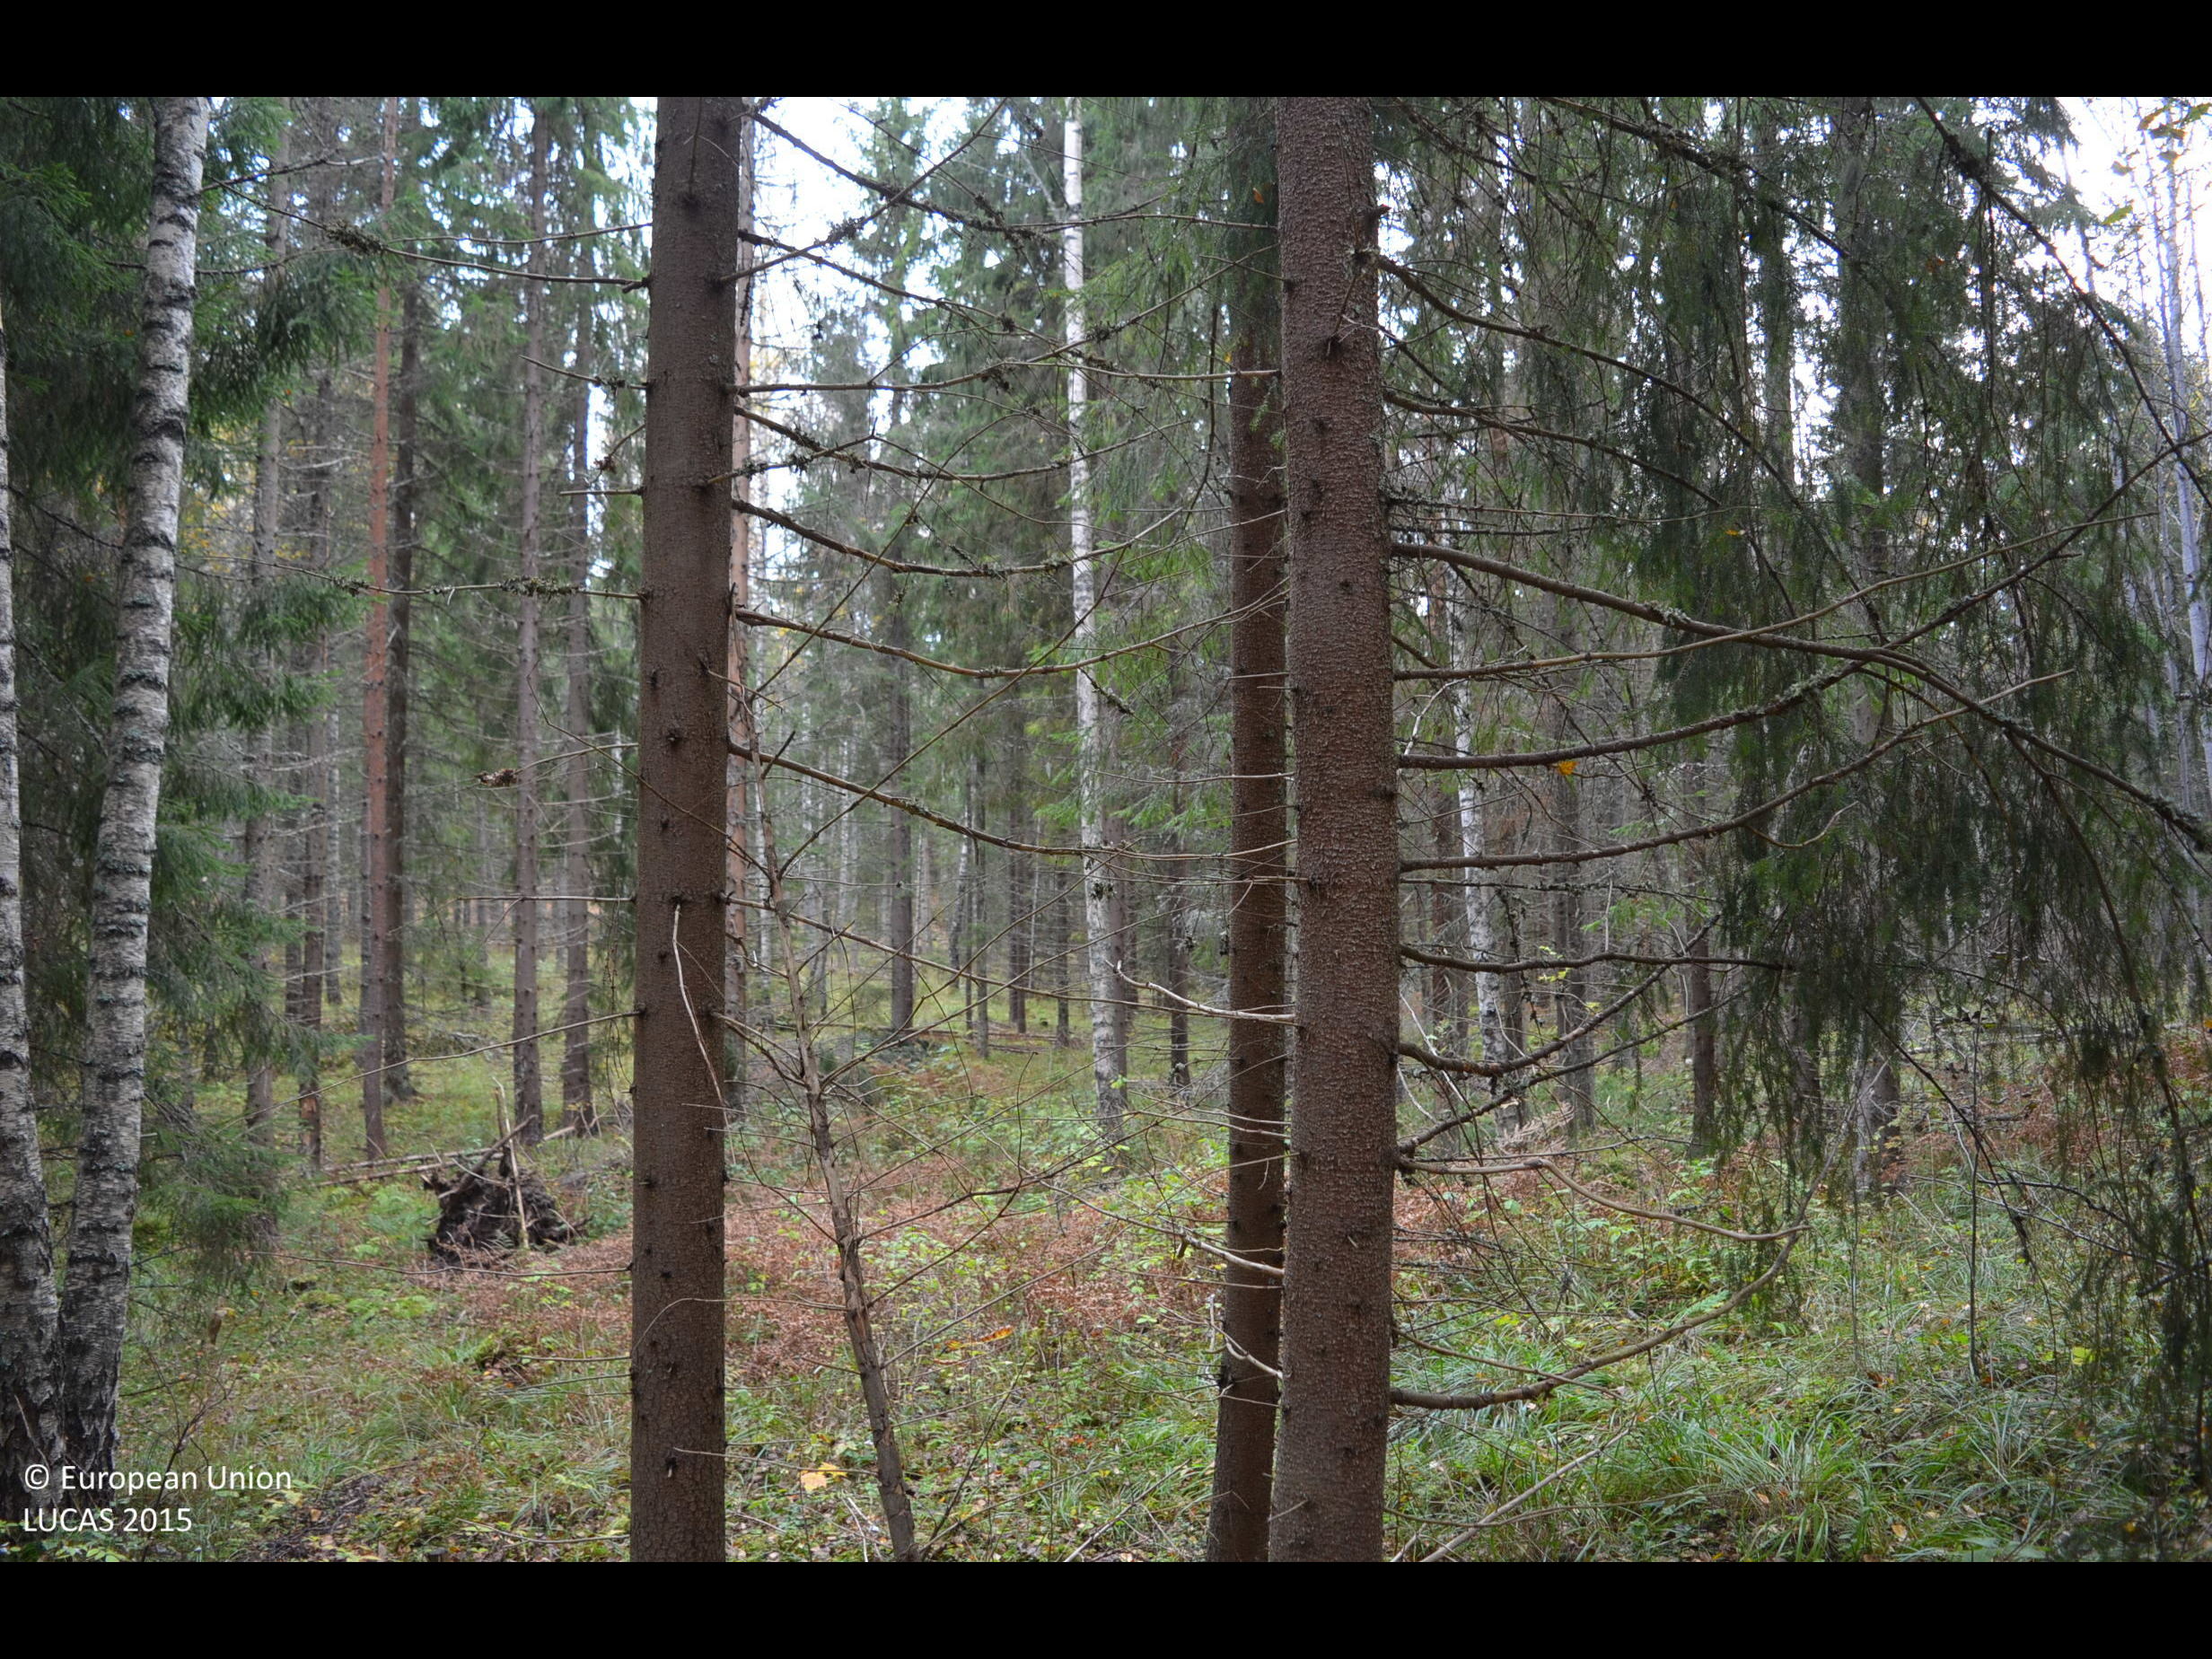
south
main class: Woodland
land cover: Spruce dominated mixed woodland
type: boreal forest
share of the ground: > 75 %
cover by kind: coniferous forest trees 55 %, broadleaved forest trees 20 %, herbaceous plants 20 %, shrubs 5 %
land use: Forestry
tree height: > 5 m
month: October
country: FI
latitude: 61.4861
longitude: 23.3151
